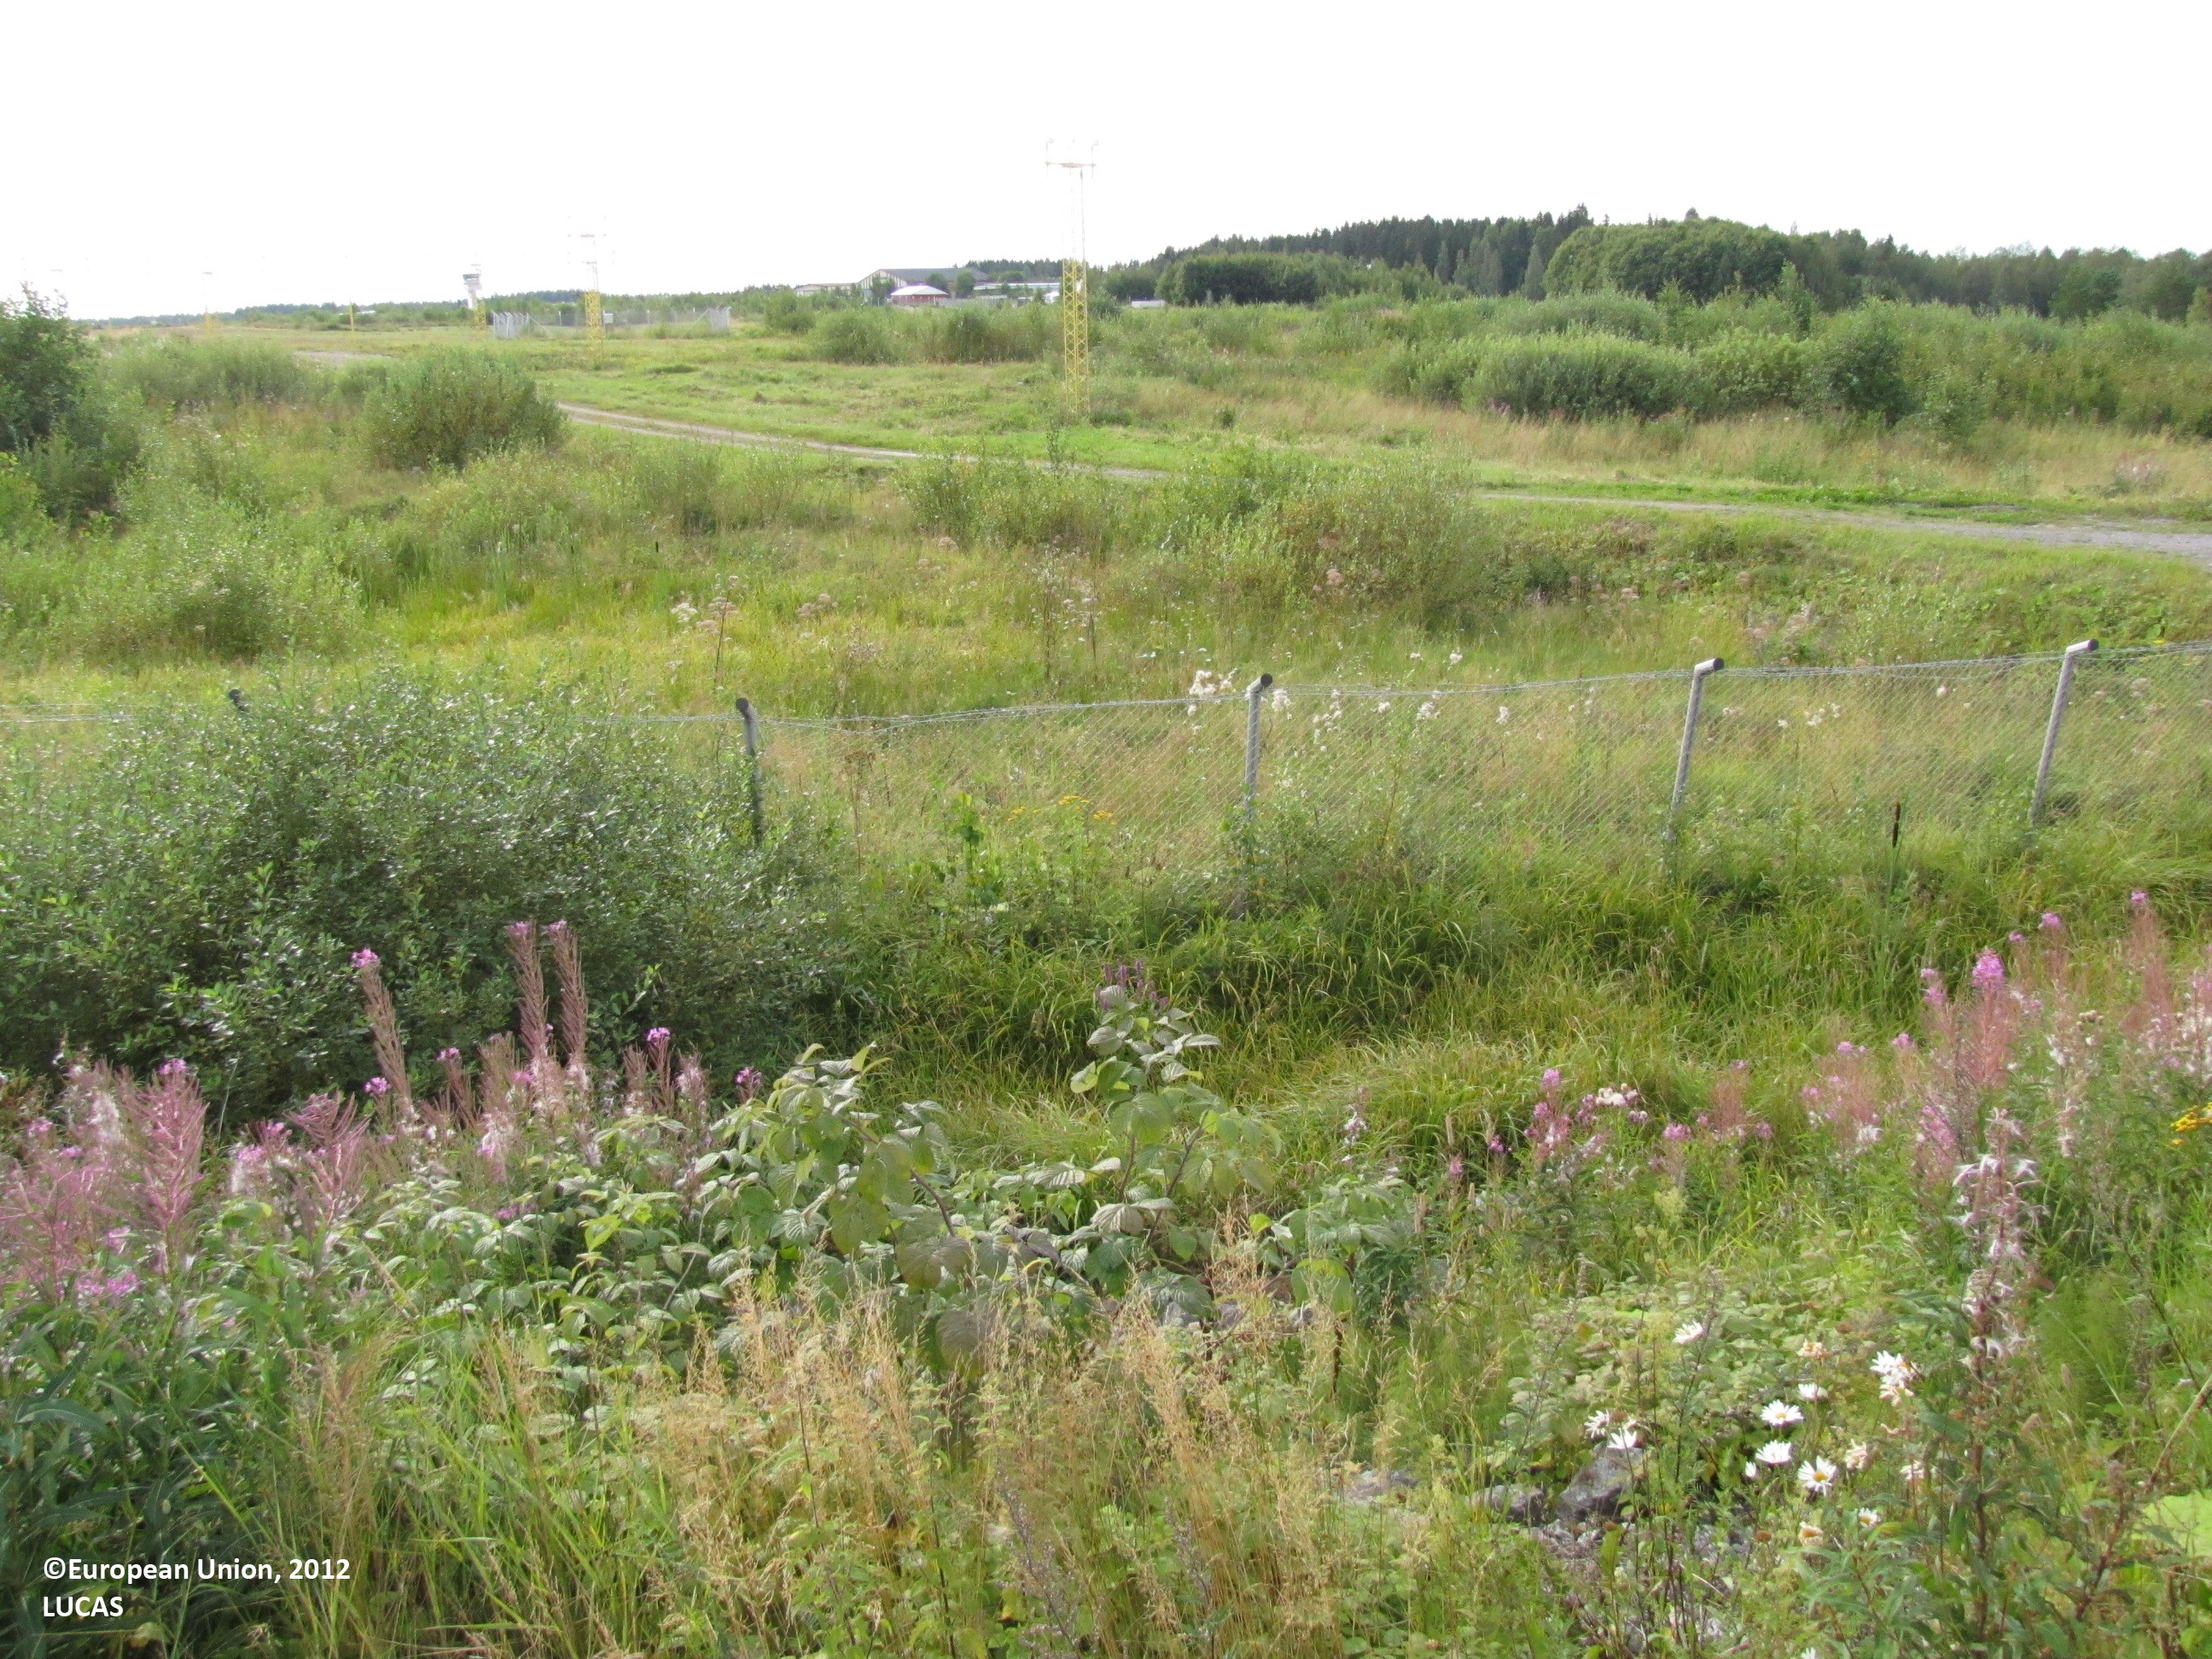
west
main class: Grassland
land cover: Grassland without tree/shrub cover
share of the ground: > 75 %
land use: Air transport
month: August
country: FI
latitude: 61.4201
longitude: 23.6304
